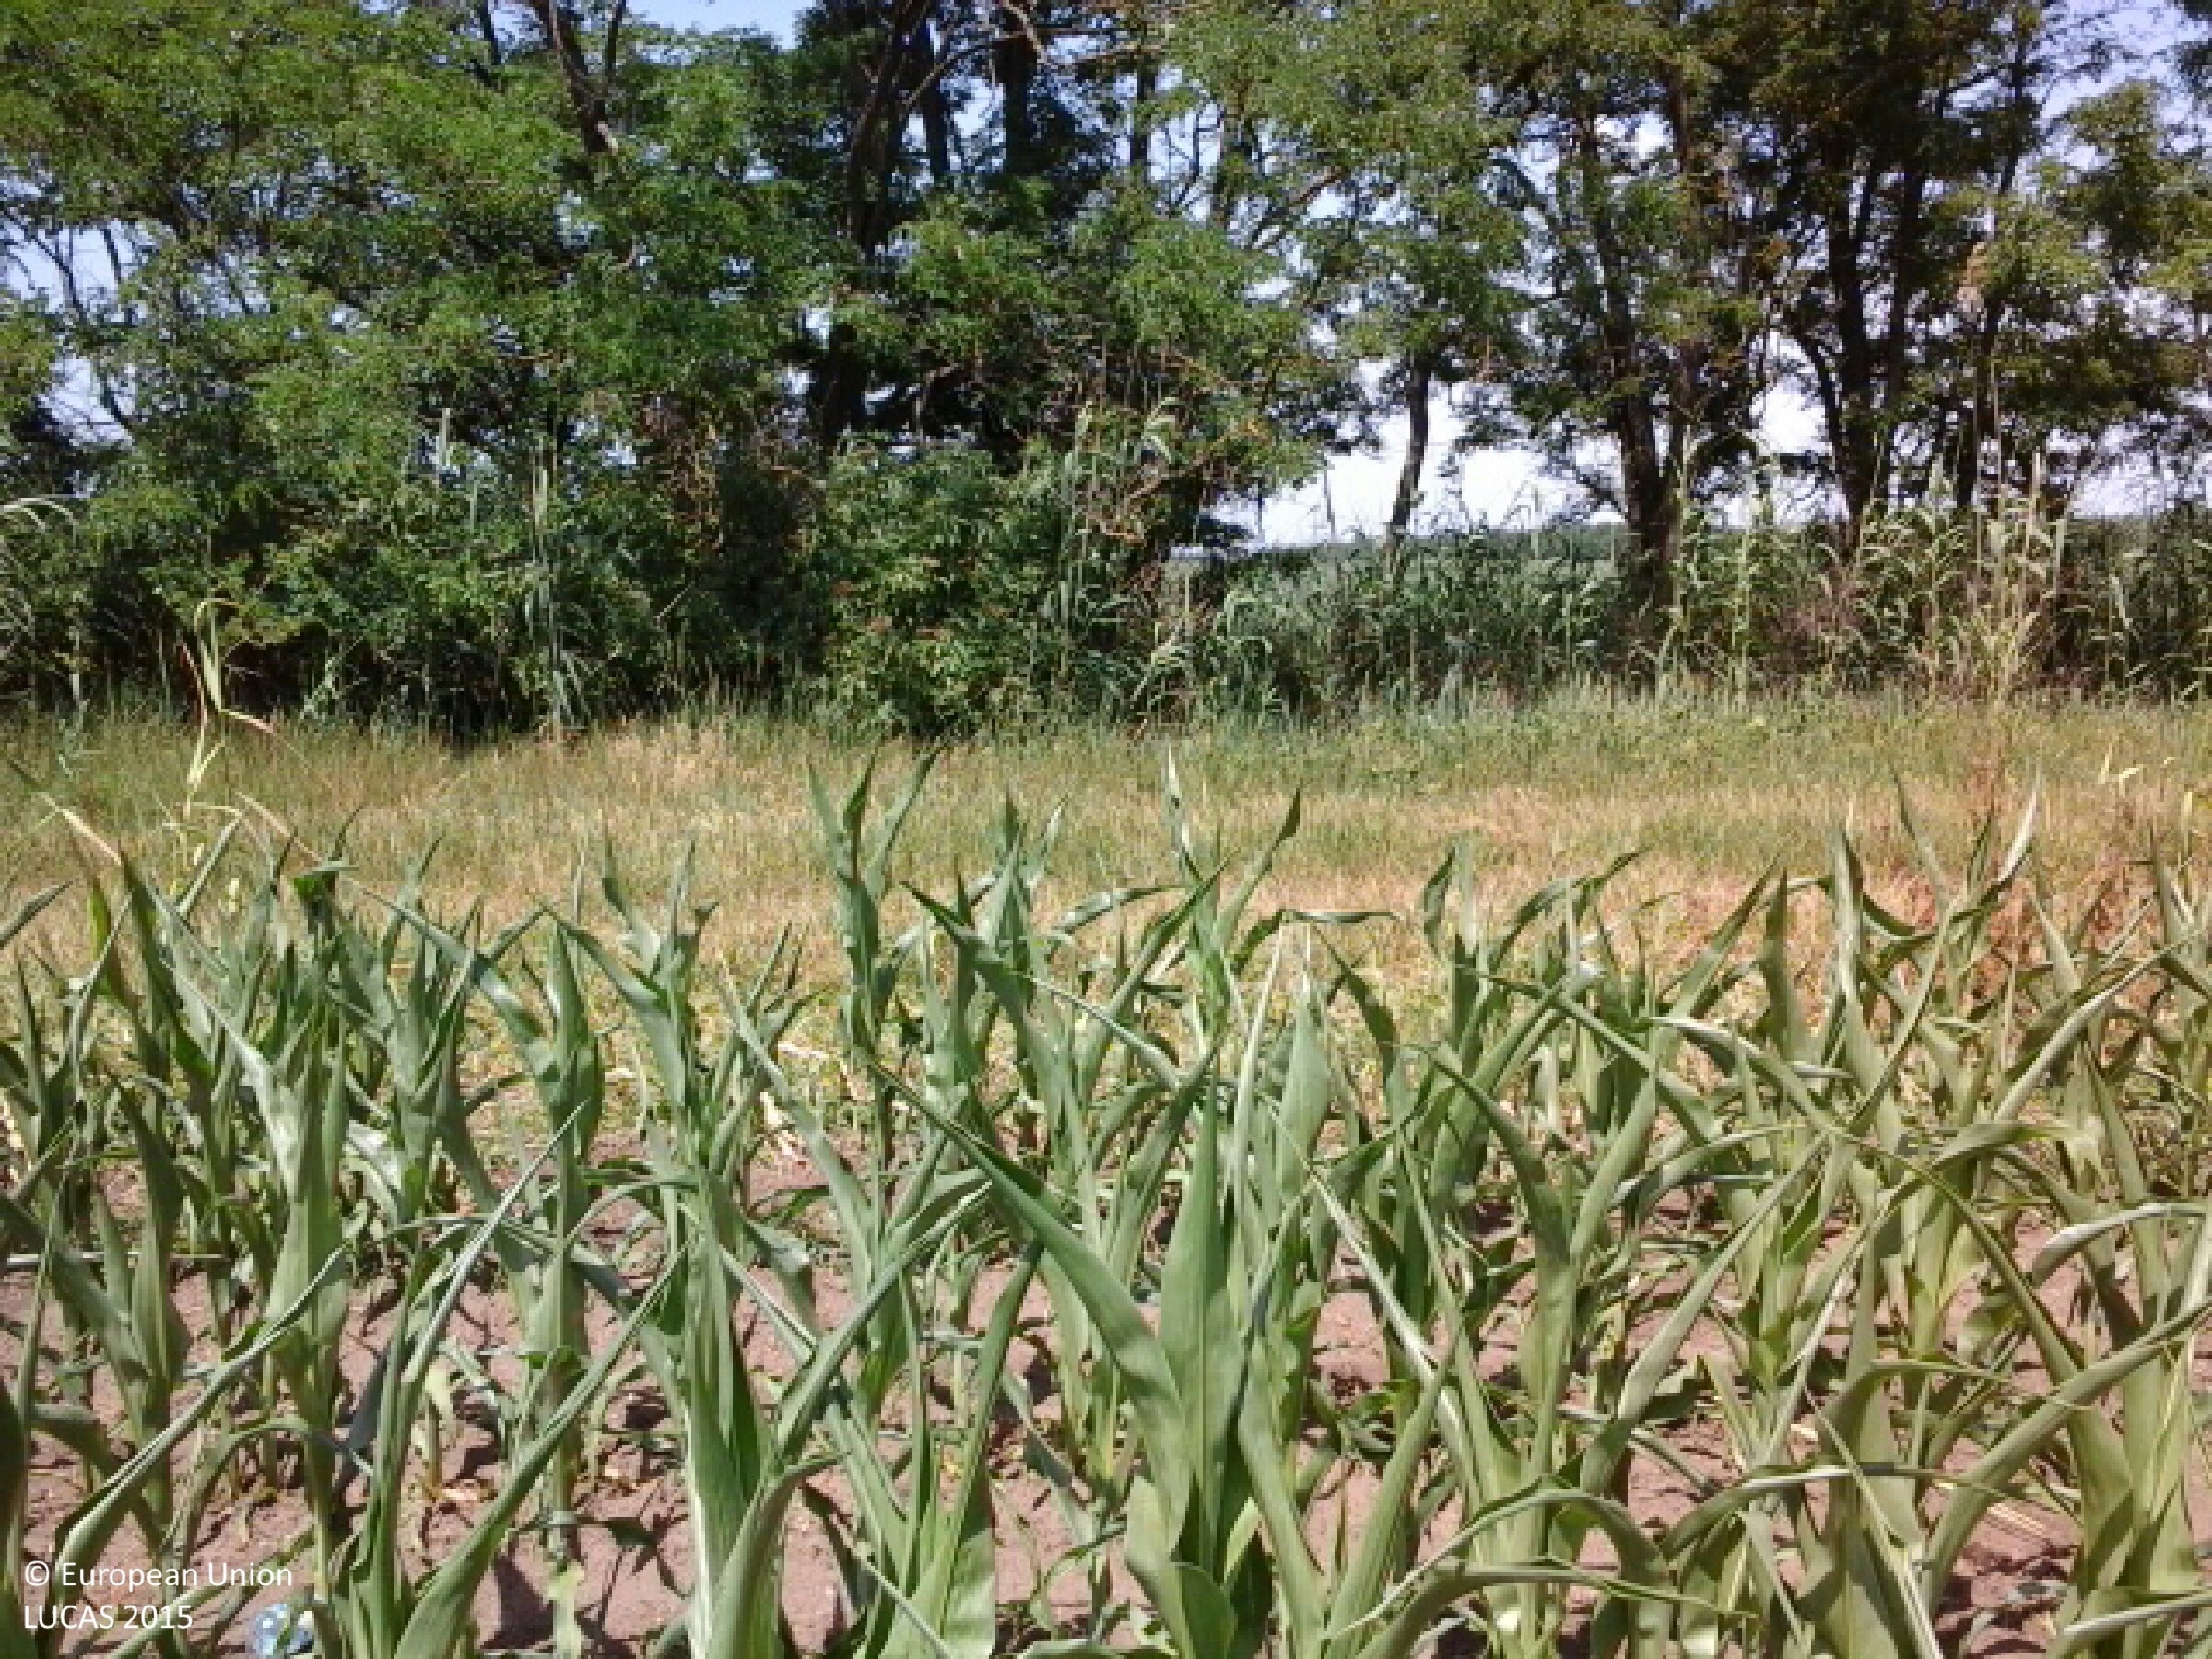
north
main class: Cropland
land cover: Maize
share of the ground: 50 - 75 %
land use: Agriculture (excluding fallow land and kitchen gardens)
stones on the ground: < 10 %
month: June
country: HU
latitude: 47.8539
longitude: 21.6879
